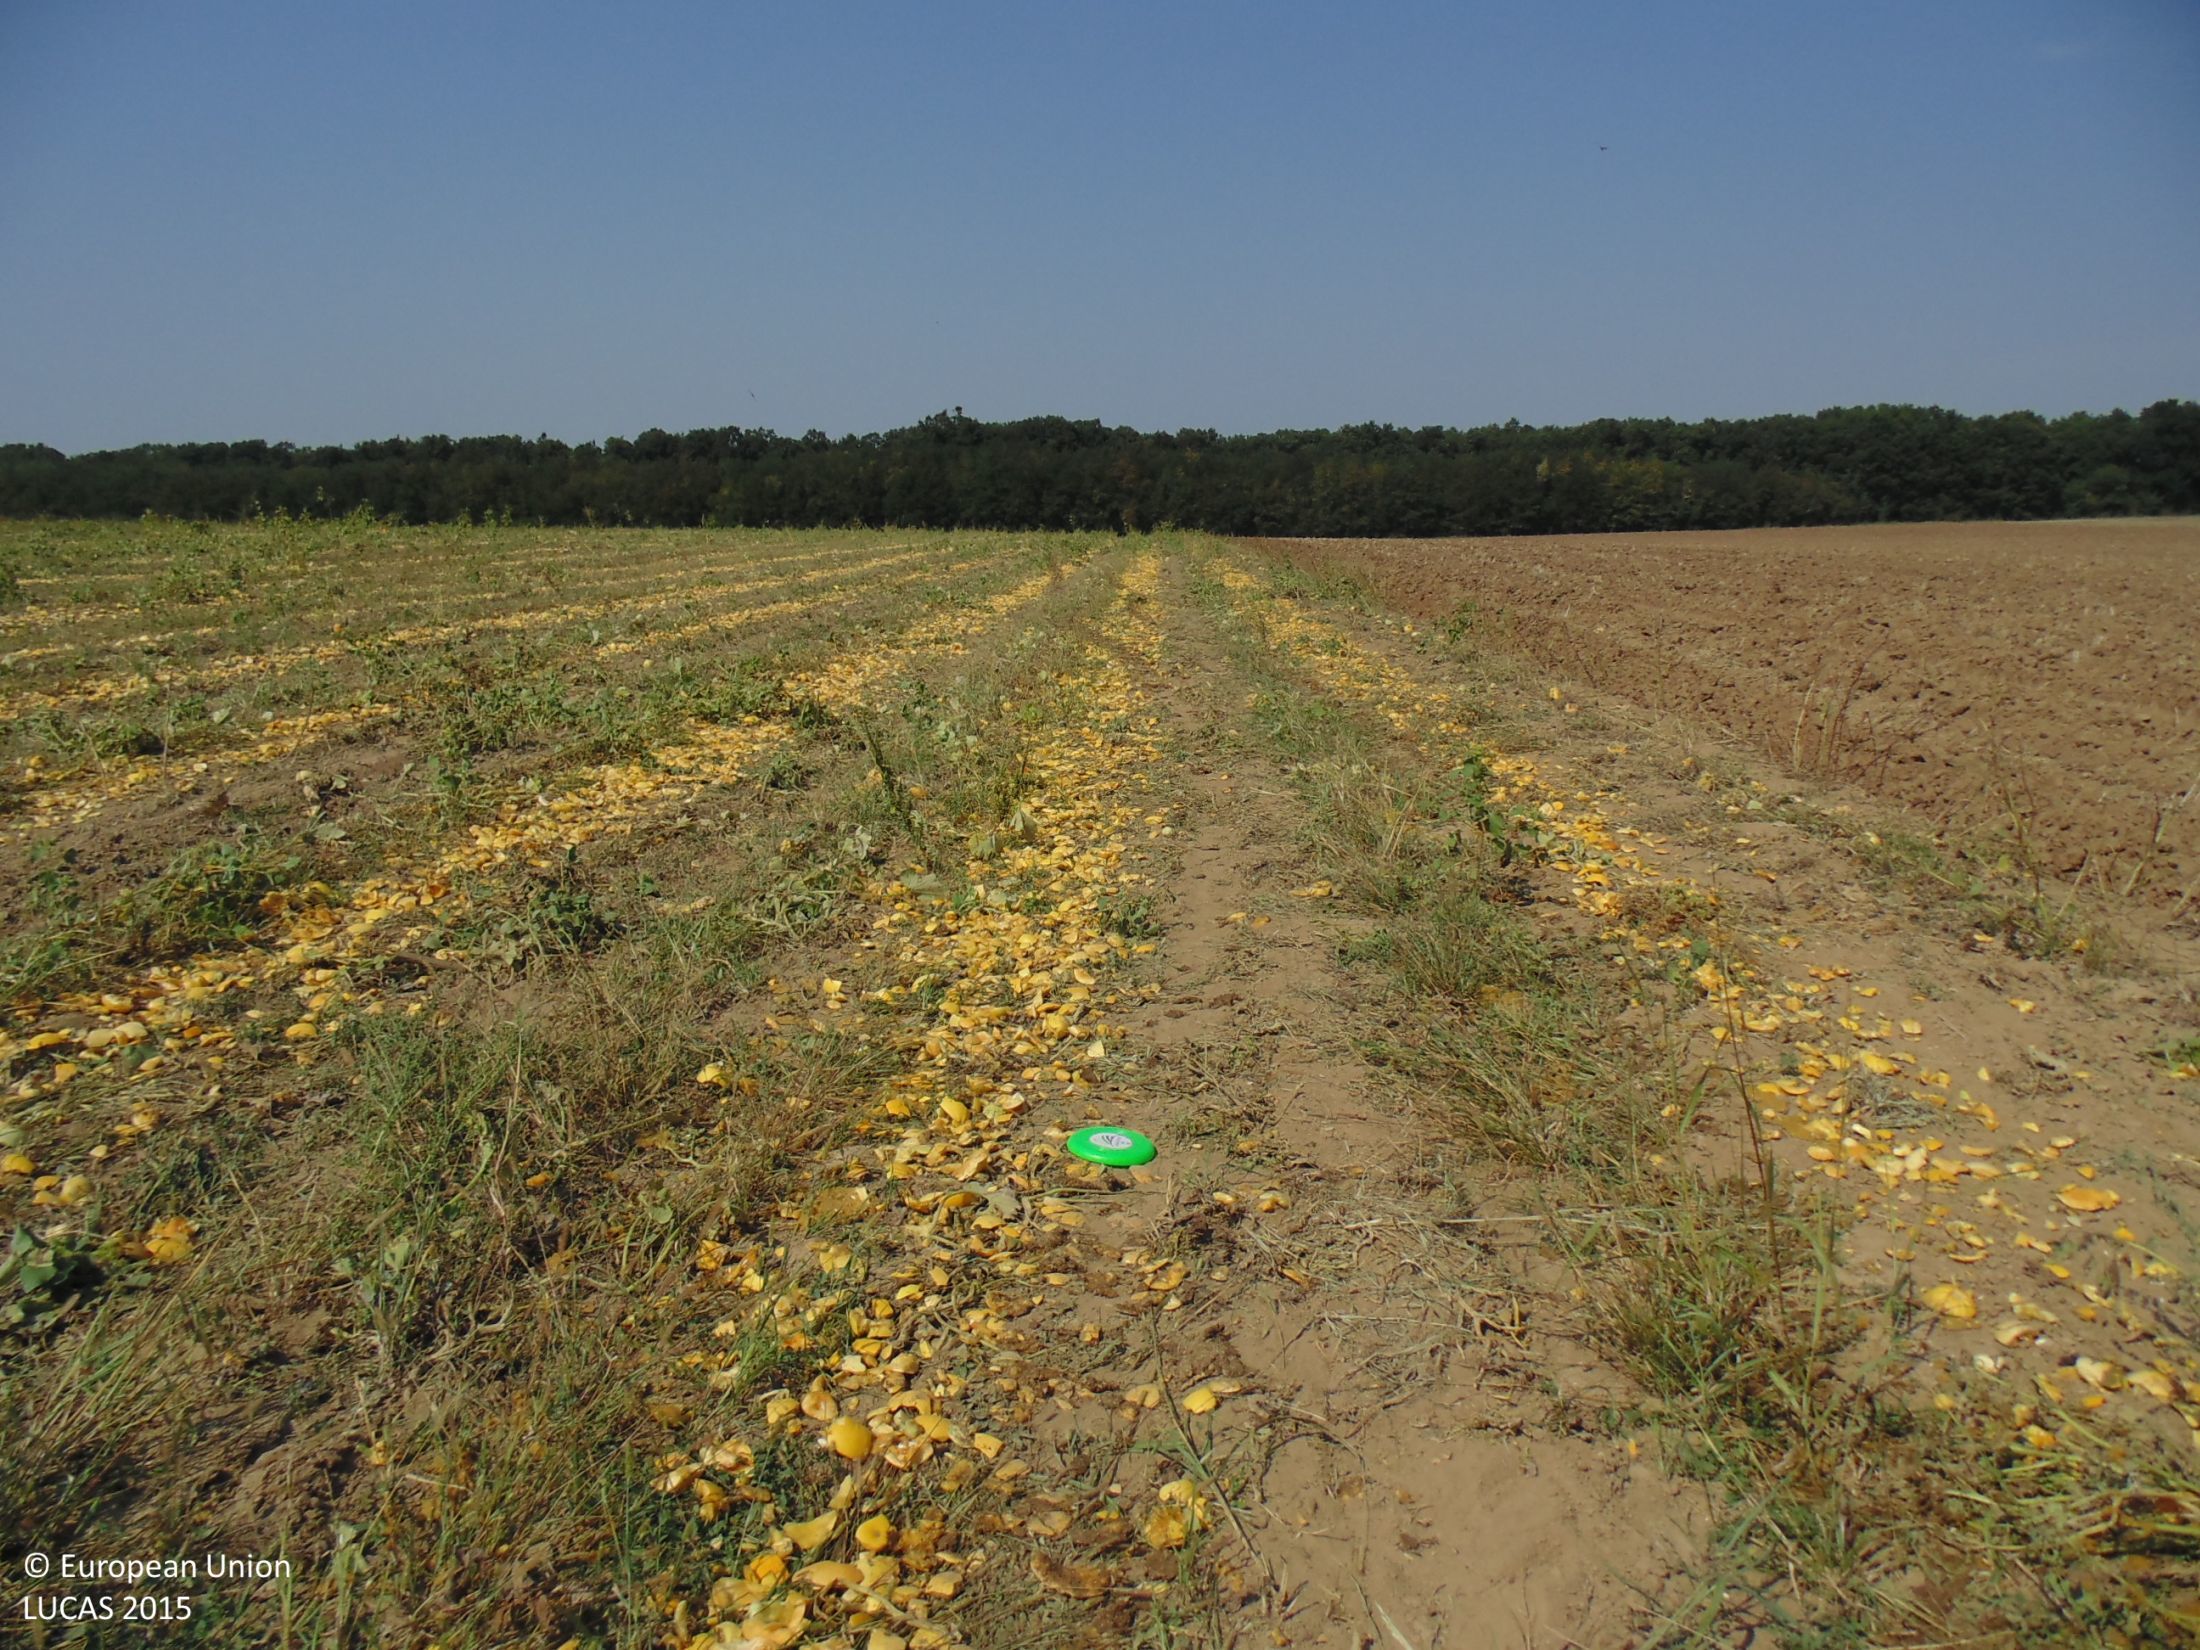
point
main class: Cropland
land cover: Other fresh vegetables
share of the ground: 25 - 50 %
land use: Agriculture (excluding fallow land and kitchen gardens)
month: September
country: BG
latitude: 43.8453
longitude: 26.9496
